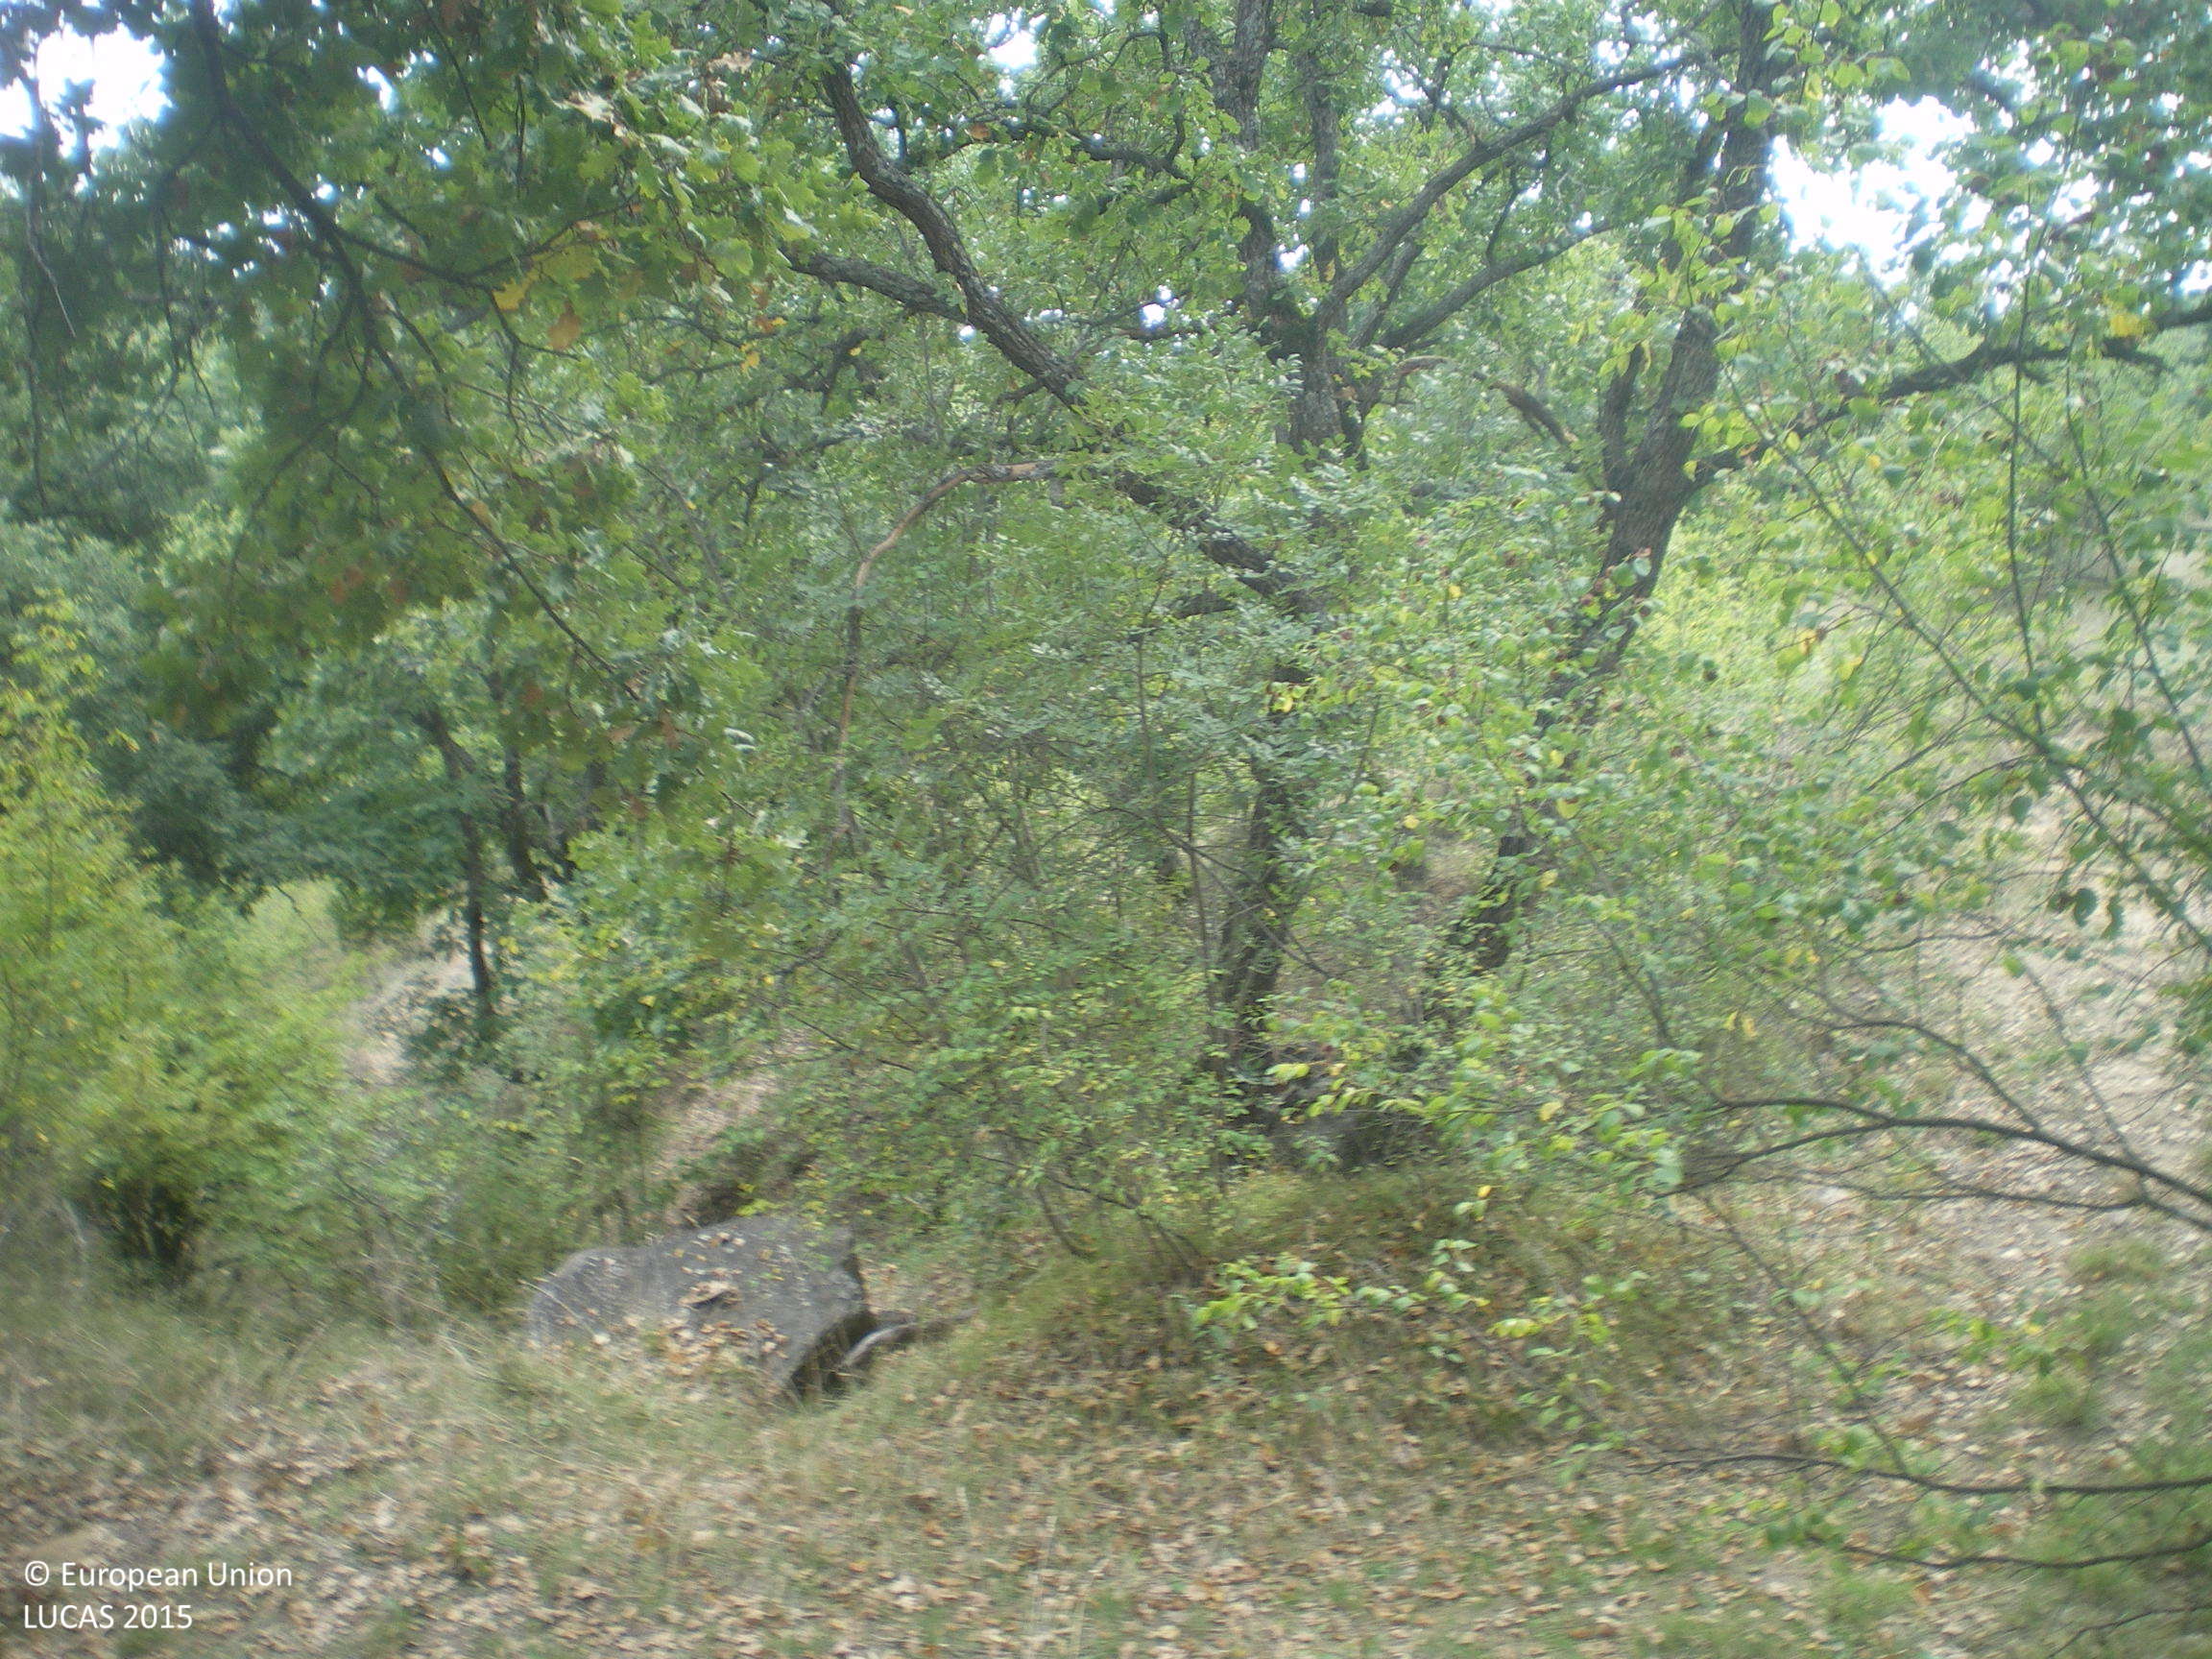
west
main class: Woodland
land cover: Broadleaved woodland
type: mesophytic deciduous forest
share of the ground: > 75 %
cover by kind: broadleaved forest trees 60 %, unconsolidated bare surface 20 %, shrubs 10 %, herbaceous plants 10 %
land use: Forestry
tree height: > 5 m
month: September
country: BG
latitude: 41.8681
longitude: 25.8893
